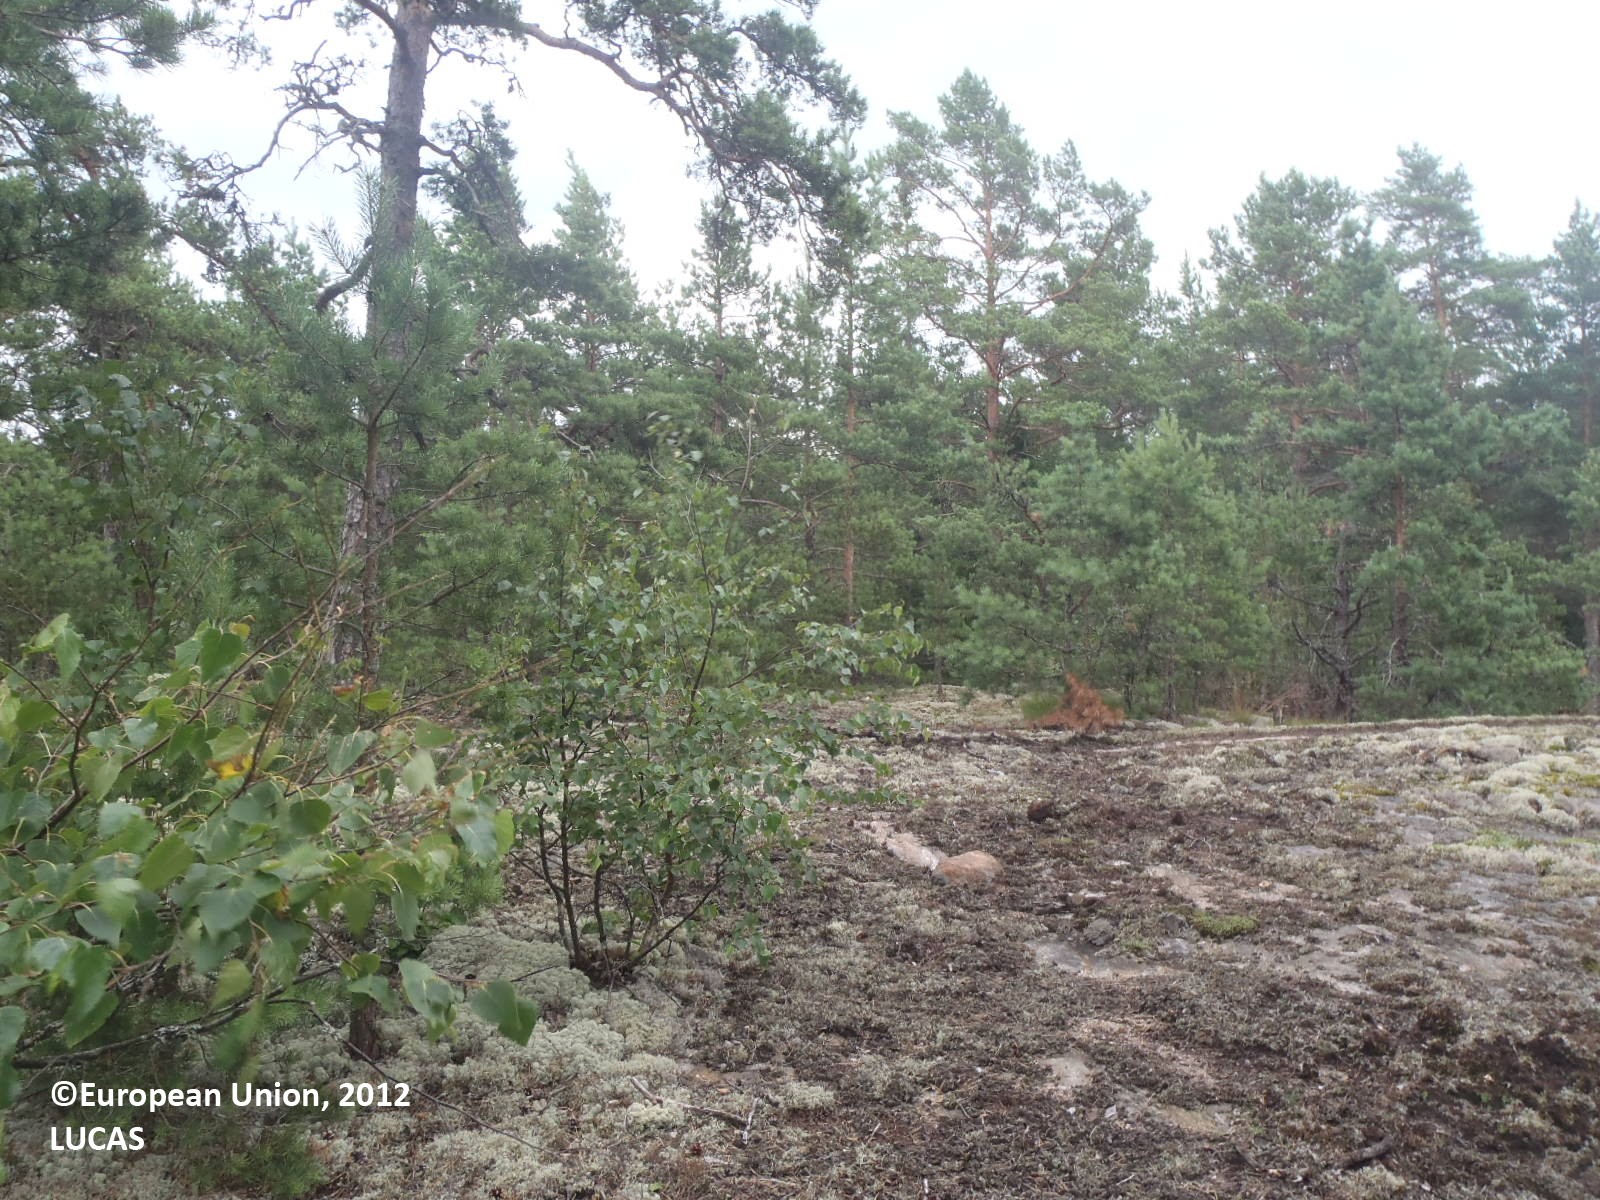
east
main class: Woodland
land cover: Pine dominated coniferous woodland
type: boreal forest
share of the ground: 25 - 50 %
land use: Forestry
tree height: > 5 m
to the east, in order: Pine dominated coniferous woodland; Ditches and canals; Pine dominated coniferous woodland
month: July
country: FI
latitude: 60.3232
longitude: 21.9967
